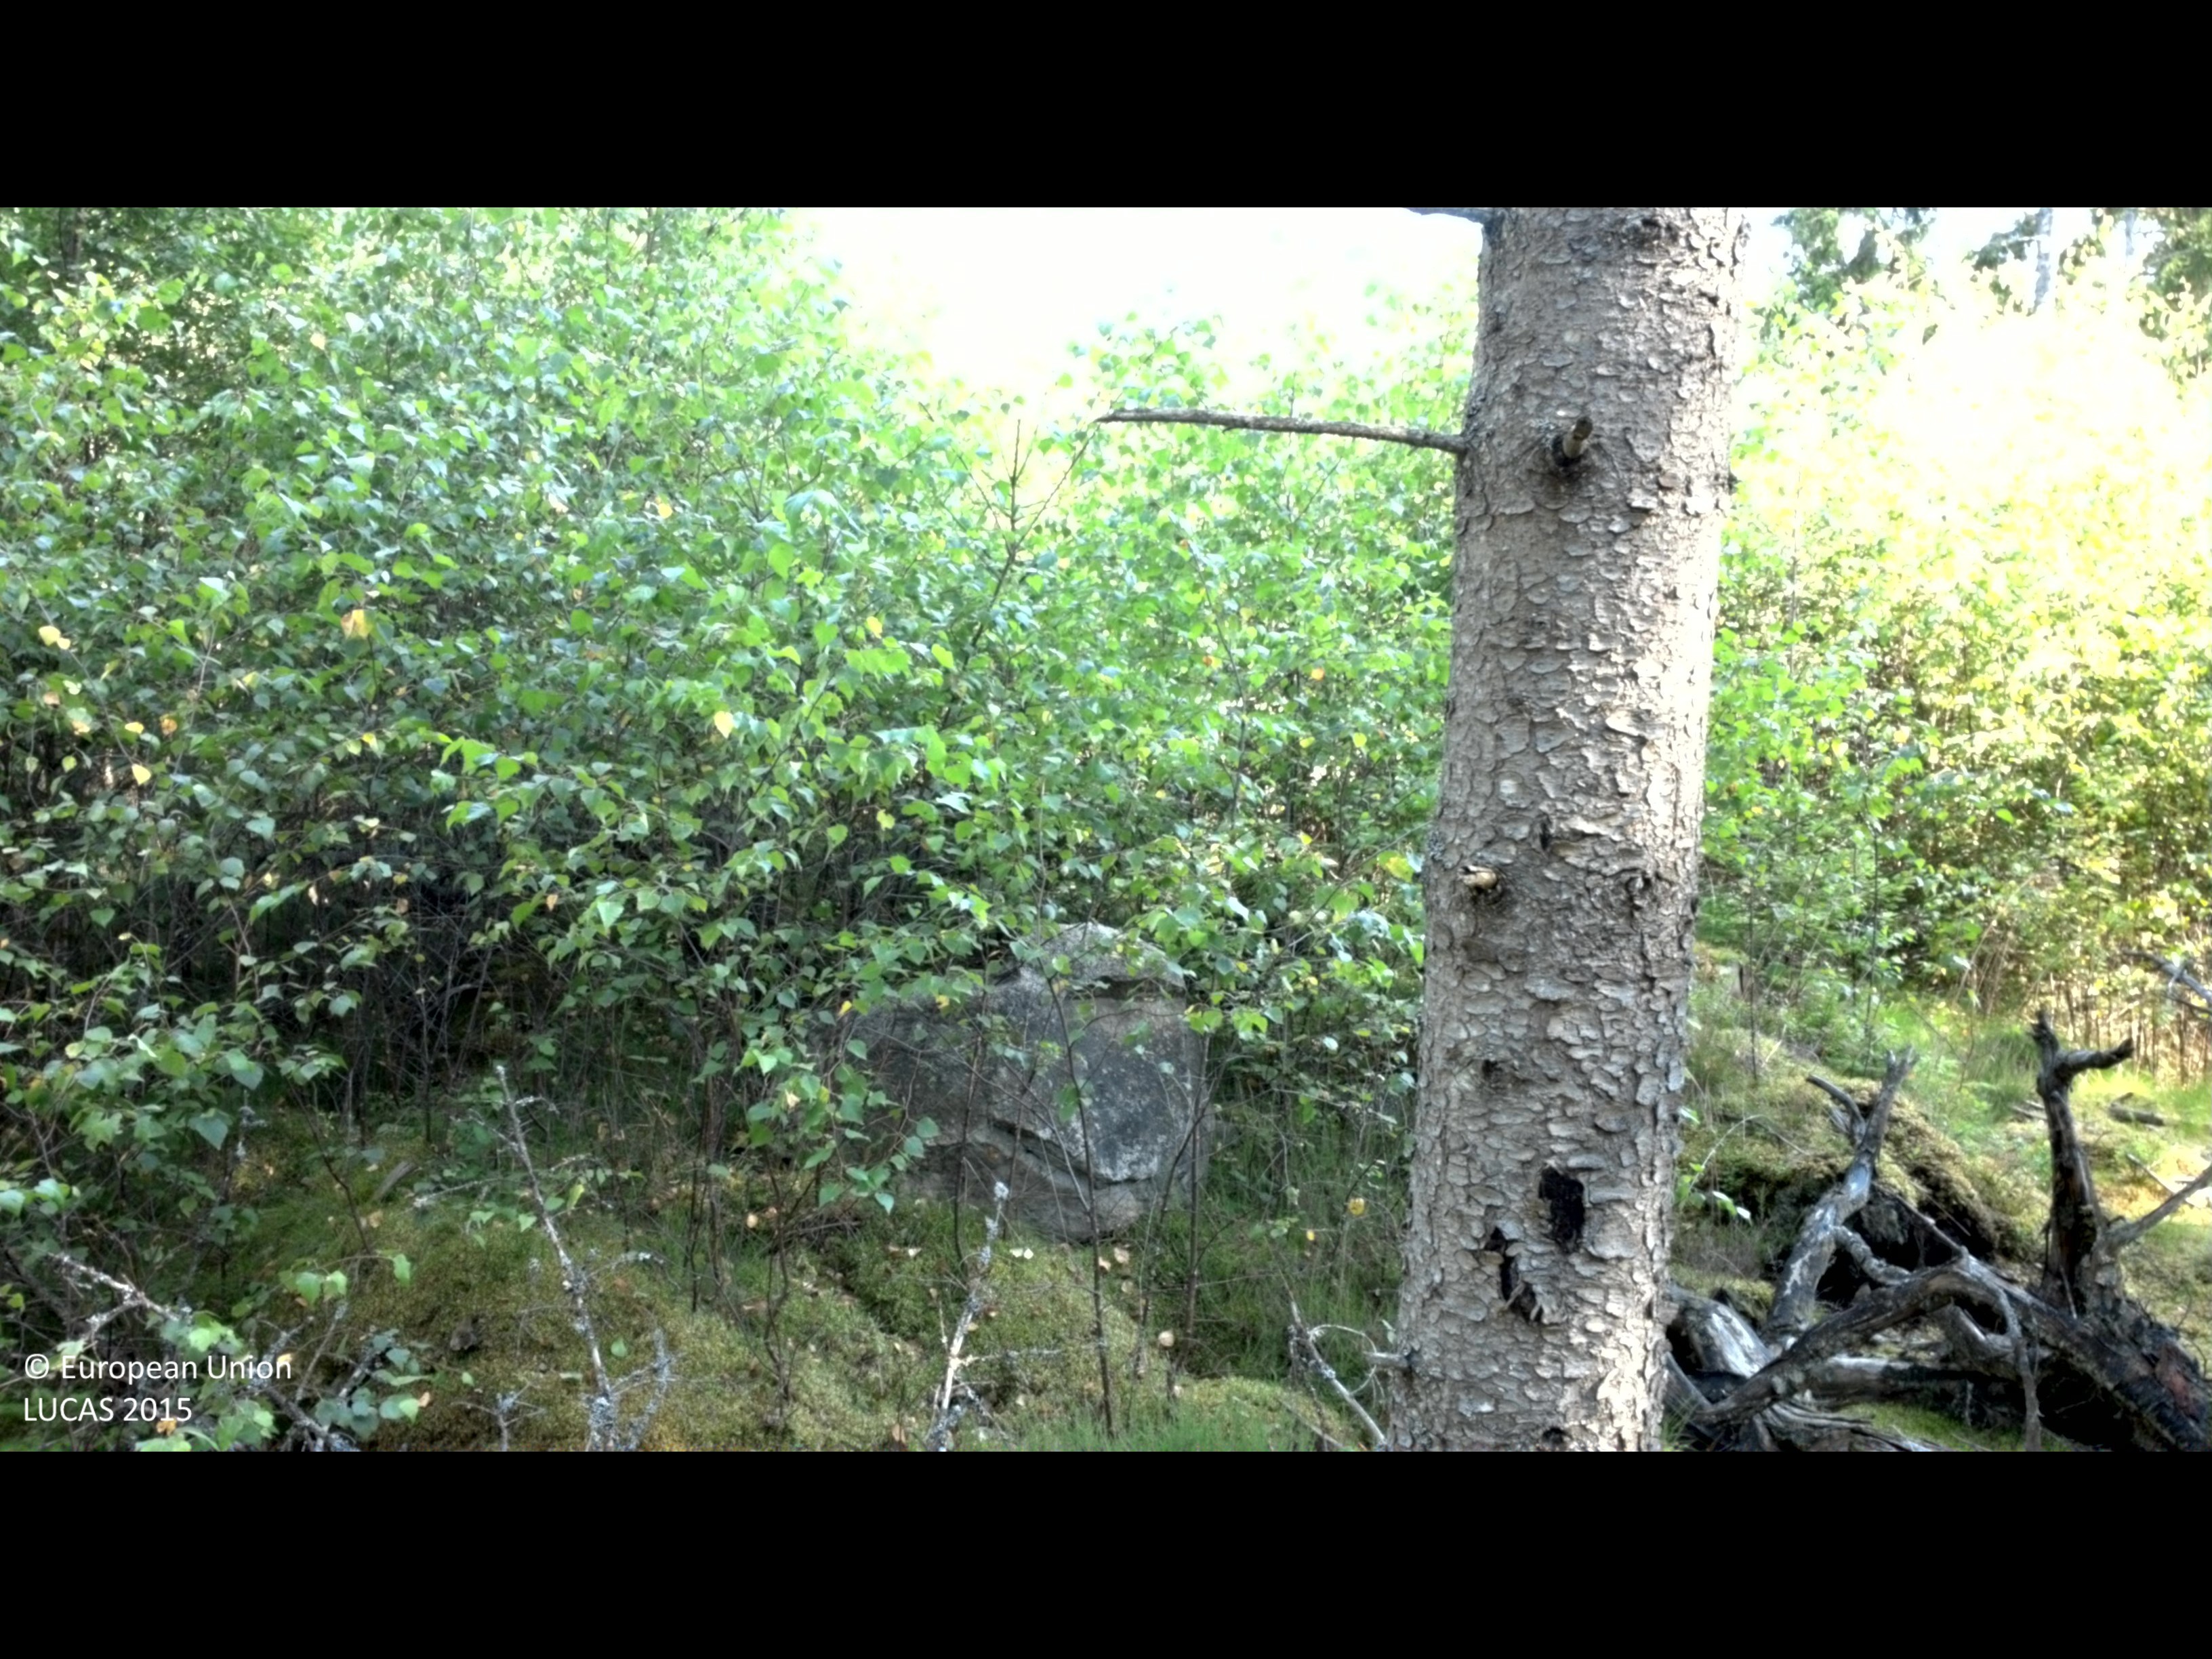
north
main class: Woodland
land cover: Spruce dominated coniferous woodland
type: boreal forest
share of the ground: 50 - 75 %
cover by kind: coniferous forest trees 70 %, lichens and mosses 20 %, shrubs 10 %
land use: Forestry
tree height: > 5 m
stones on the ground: 25 - 50 %
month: August
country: SE
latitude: 56.6457
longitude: 14.0576
